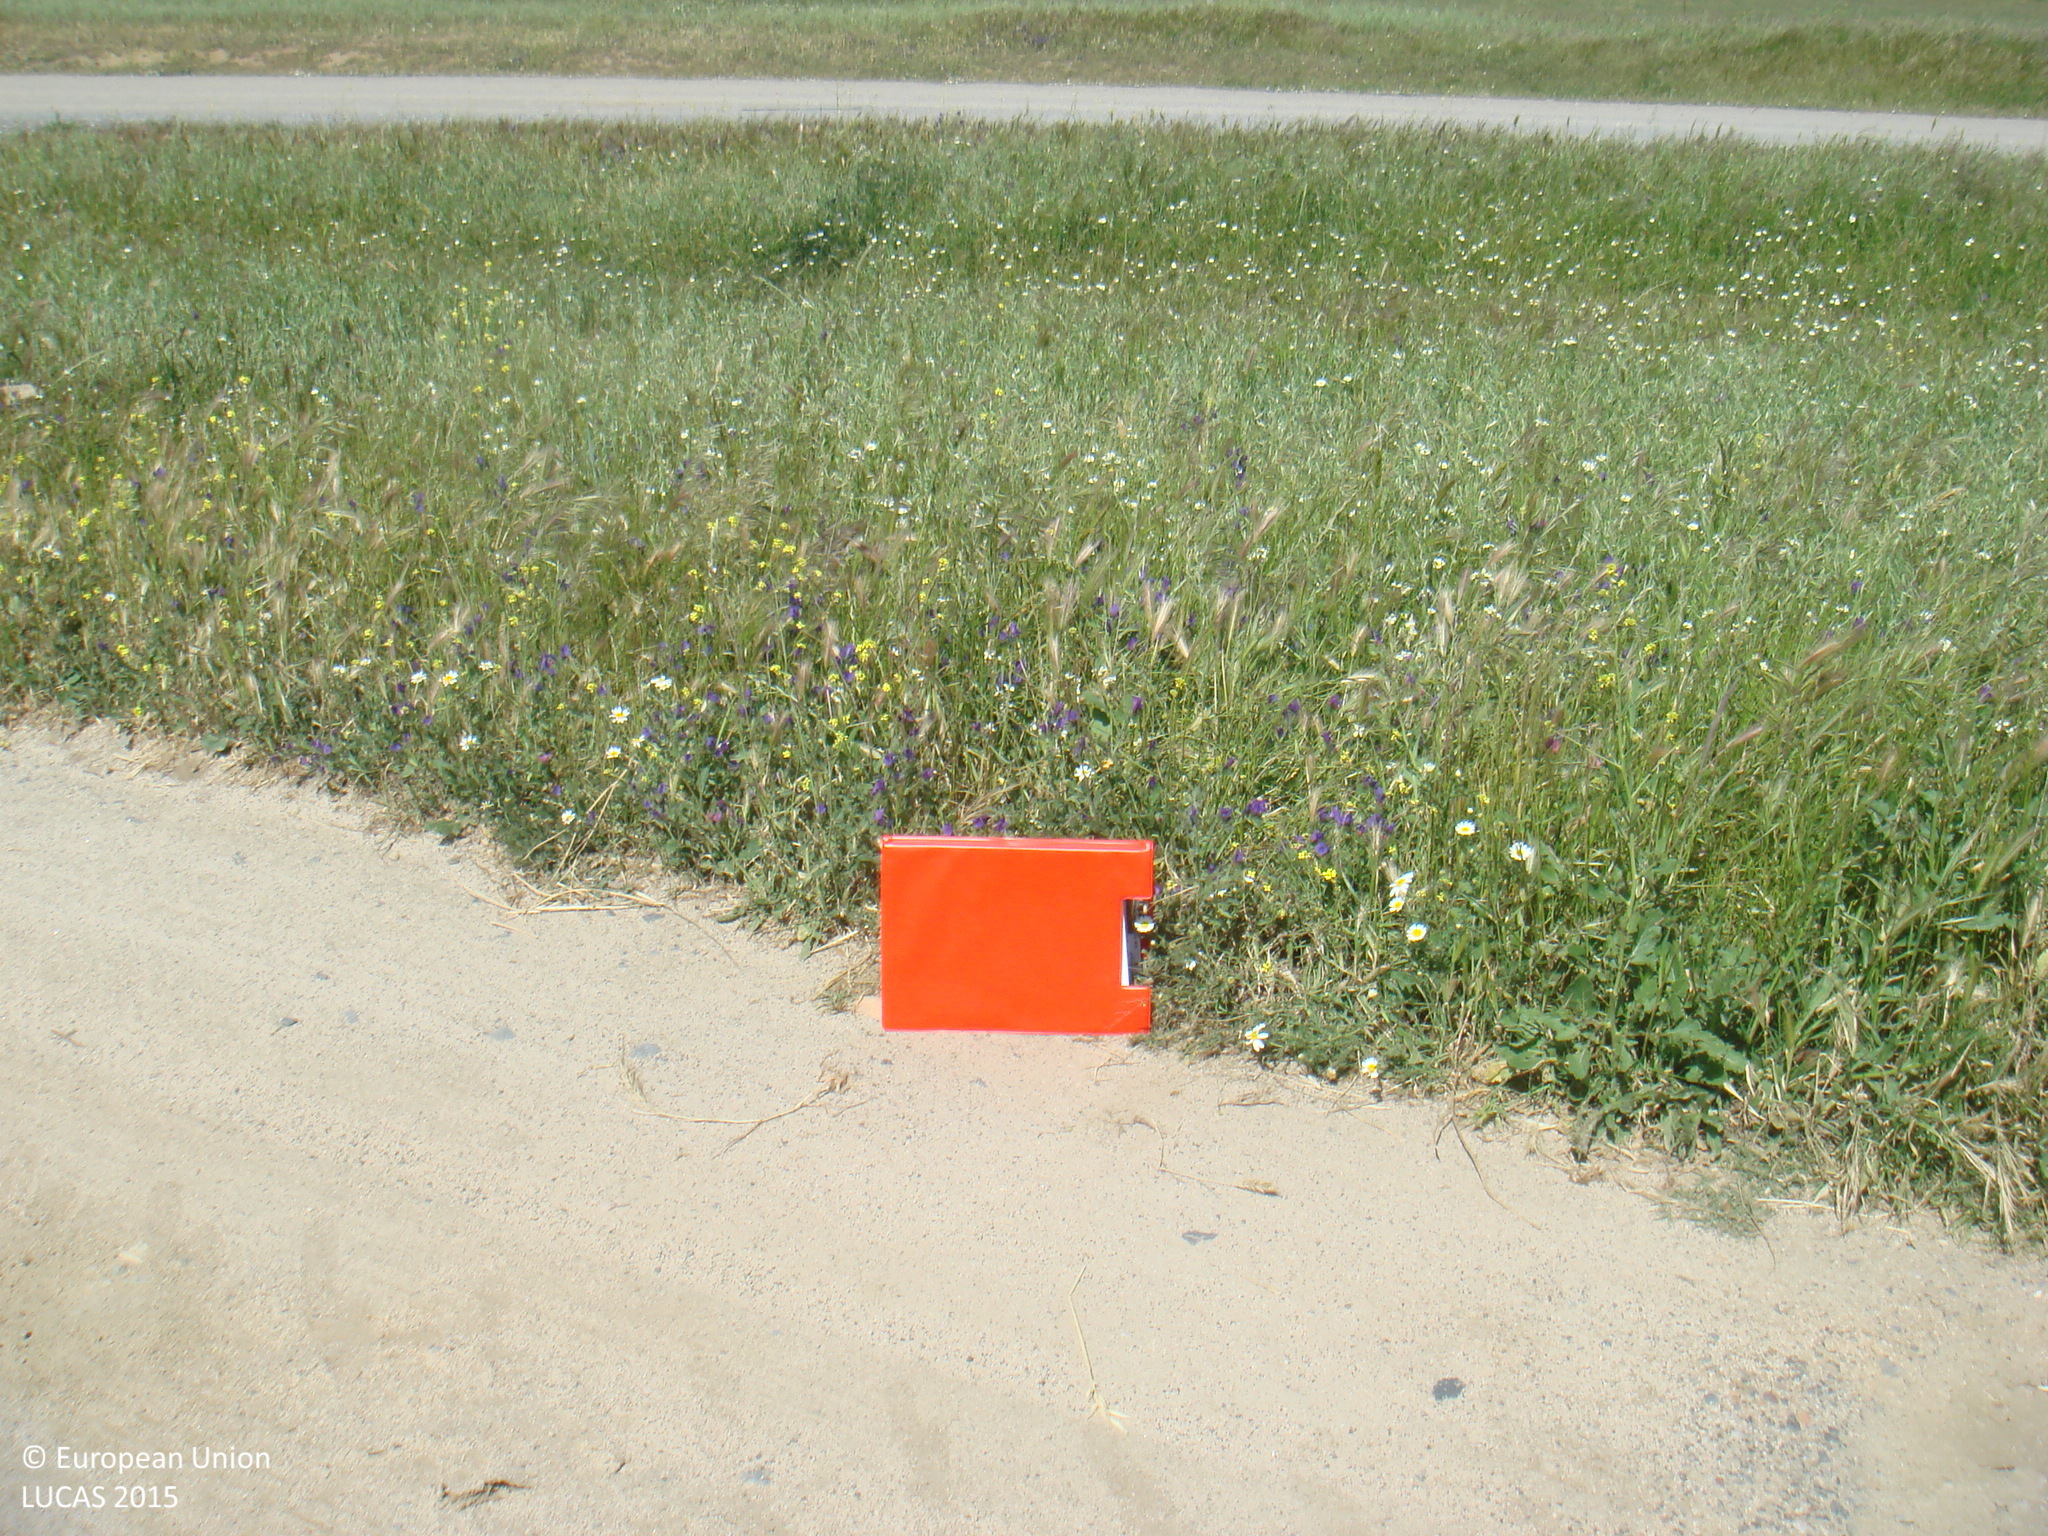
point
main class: Cropland
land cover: Mixed cereals for fodder
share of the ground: 25 - 50 %
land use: Agriculture (excluding fallow land and kitchen gardens)
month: April
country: ES
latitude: 38.4804
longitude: -5.1263
